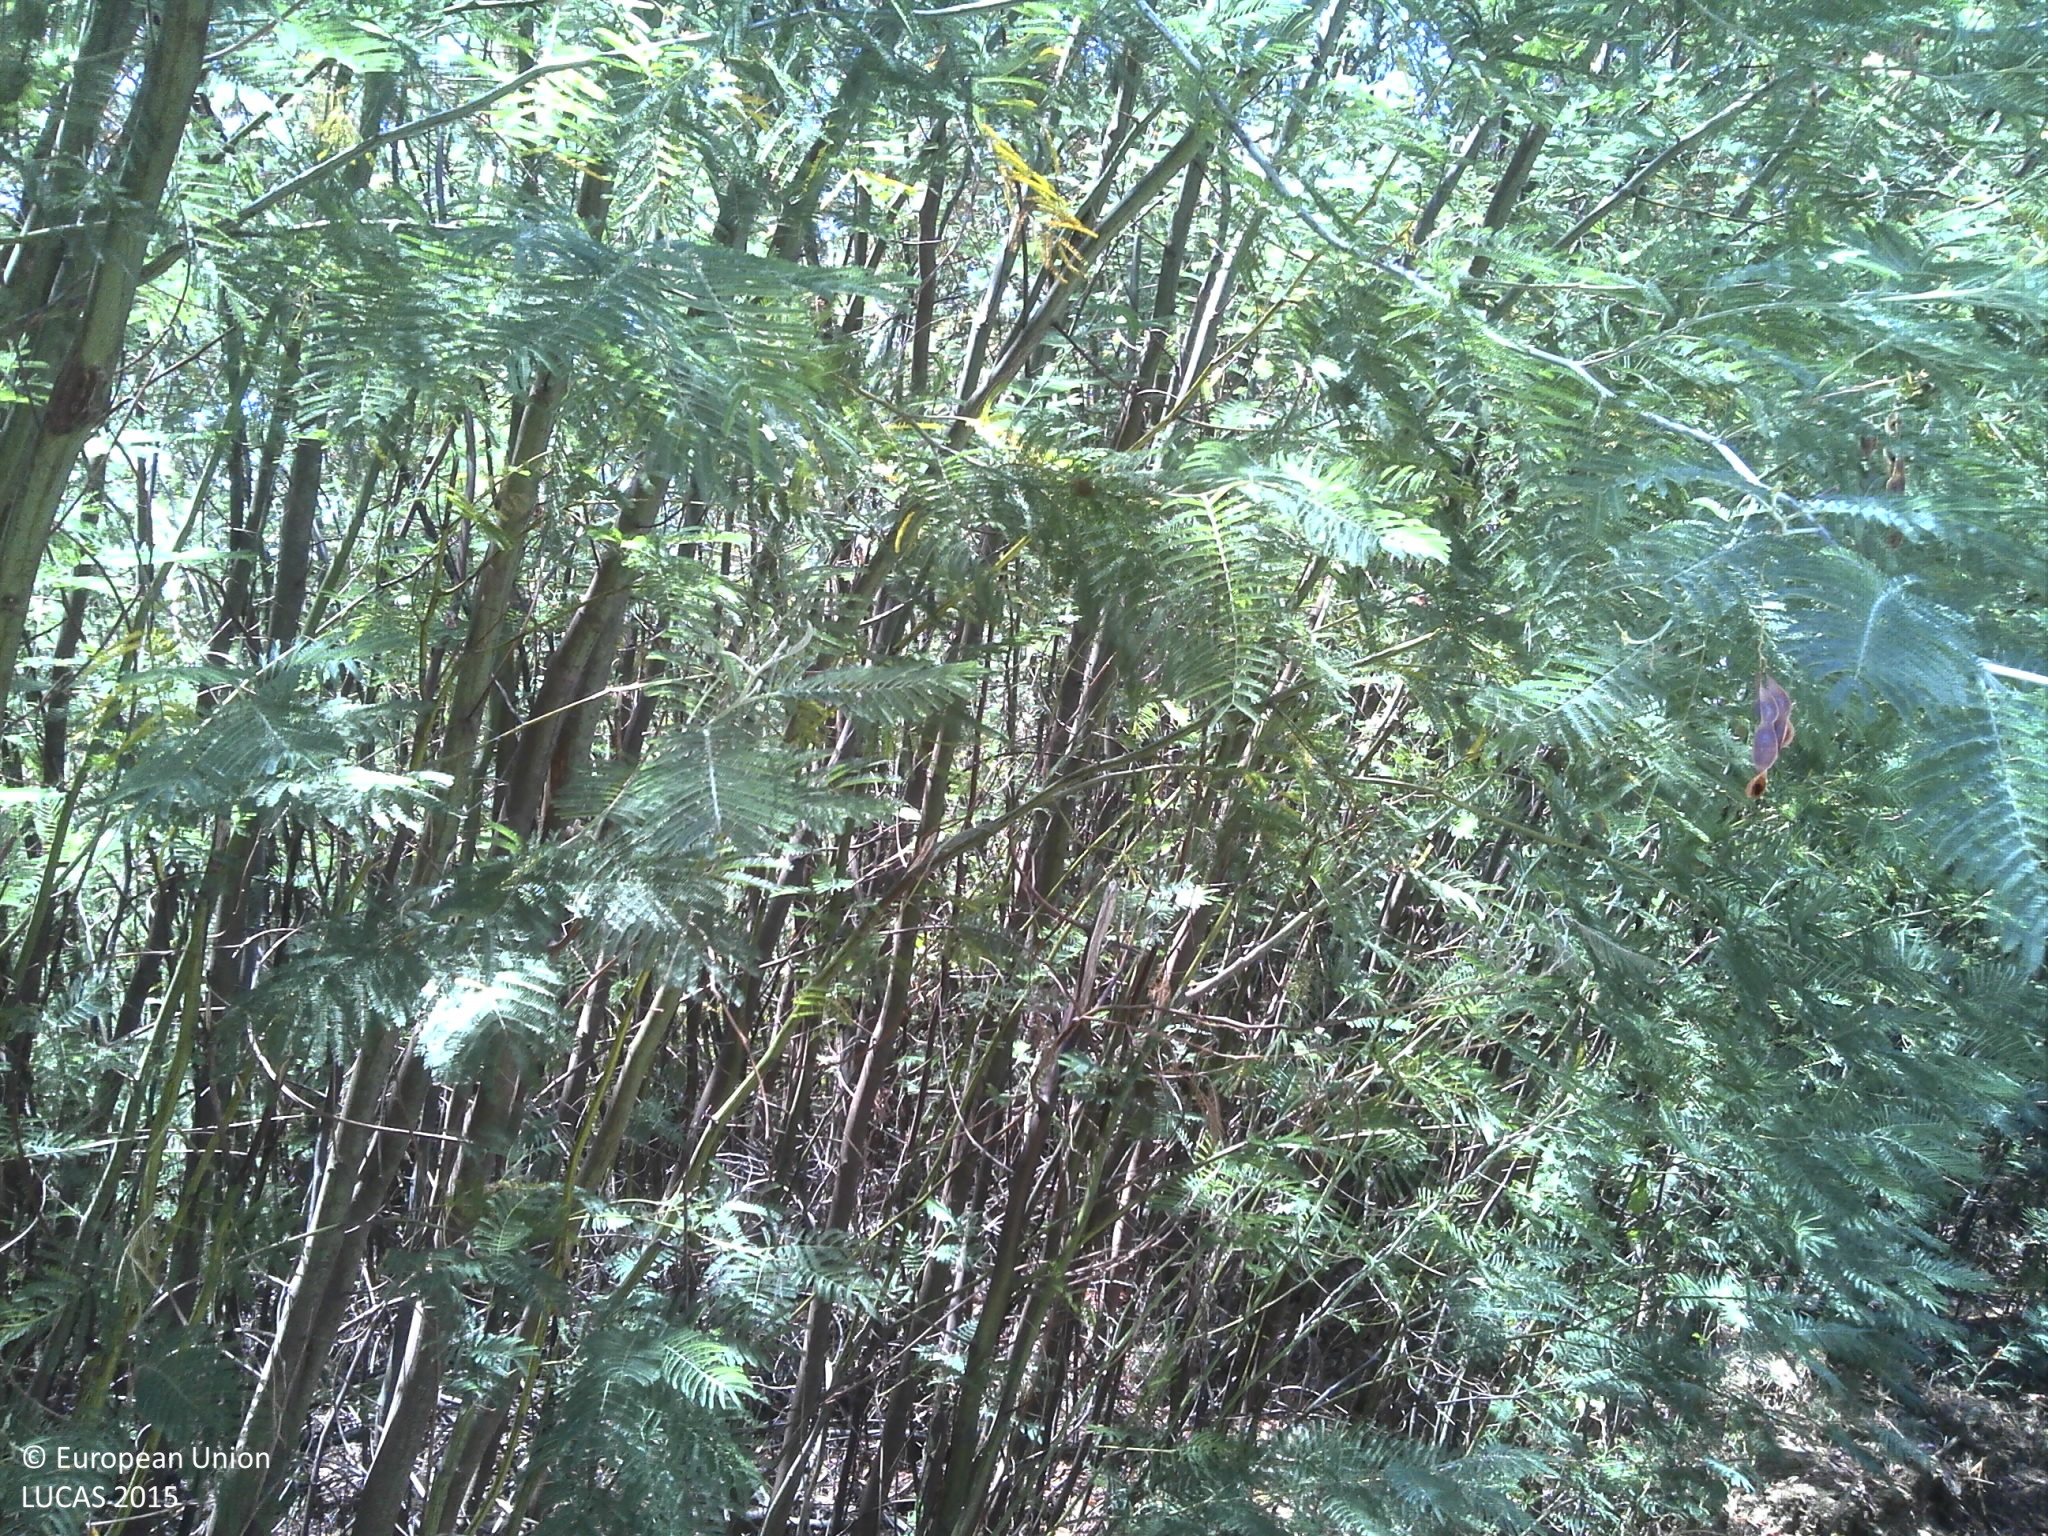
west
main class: Woodland
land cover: Broadleaved woodland
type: exotic forest
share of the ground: > 75 %
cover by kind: broadleaved forest trees 80 %, shrubs 20 %
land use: Abandoned areas
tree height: > 5 m
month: July
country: PT
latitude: 40.2451
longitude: -7.9270
